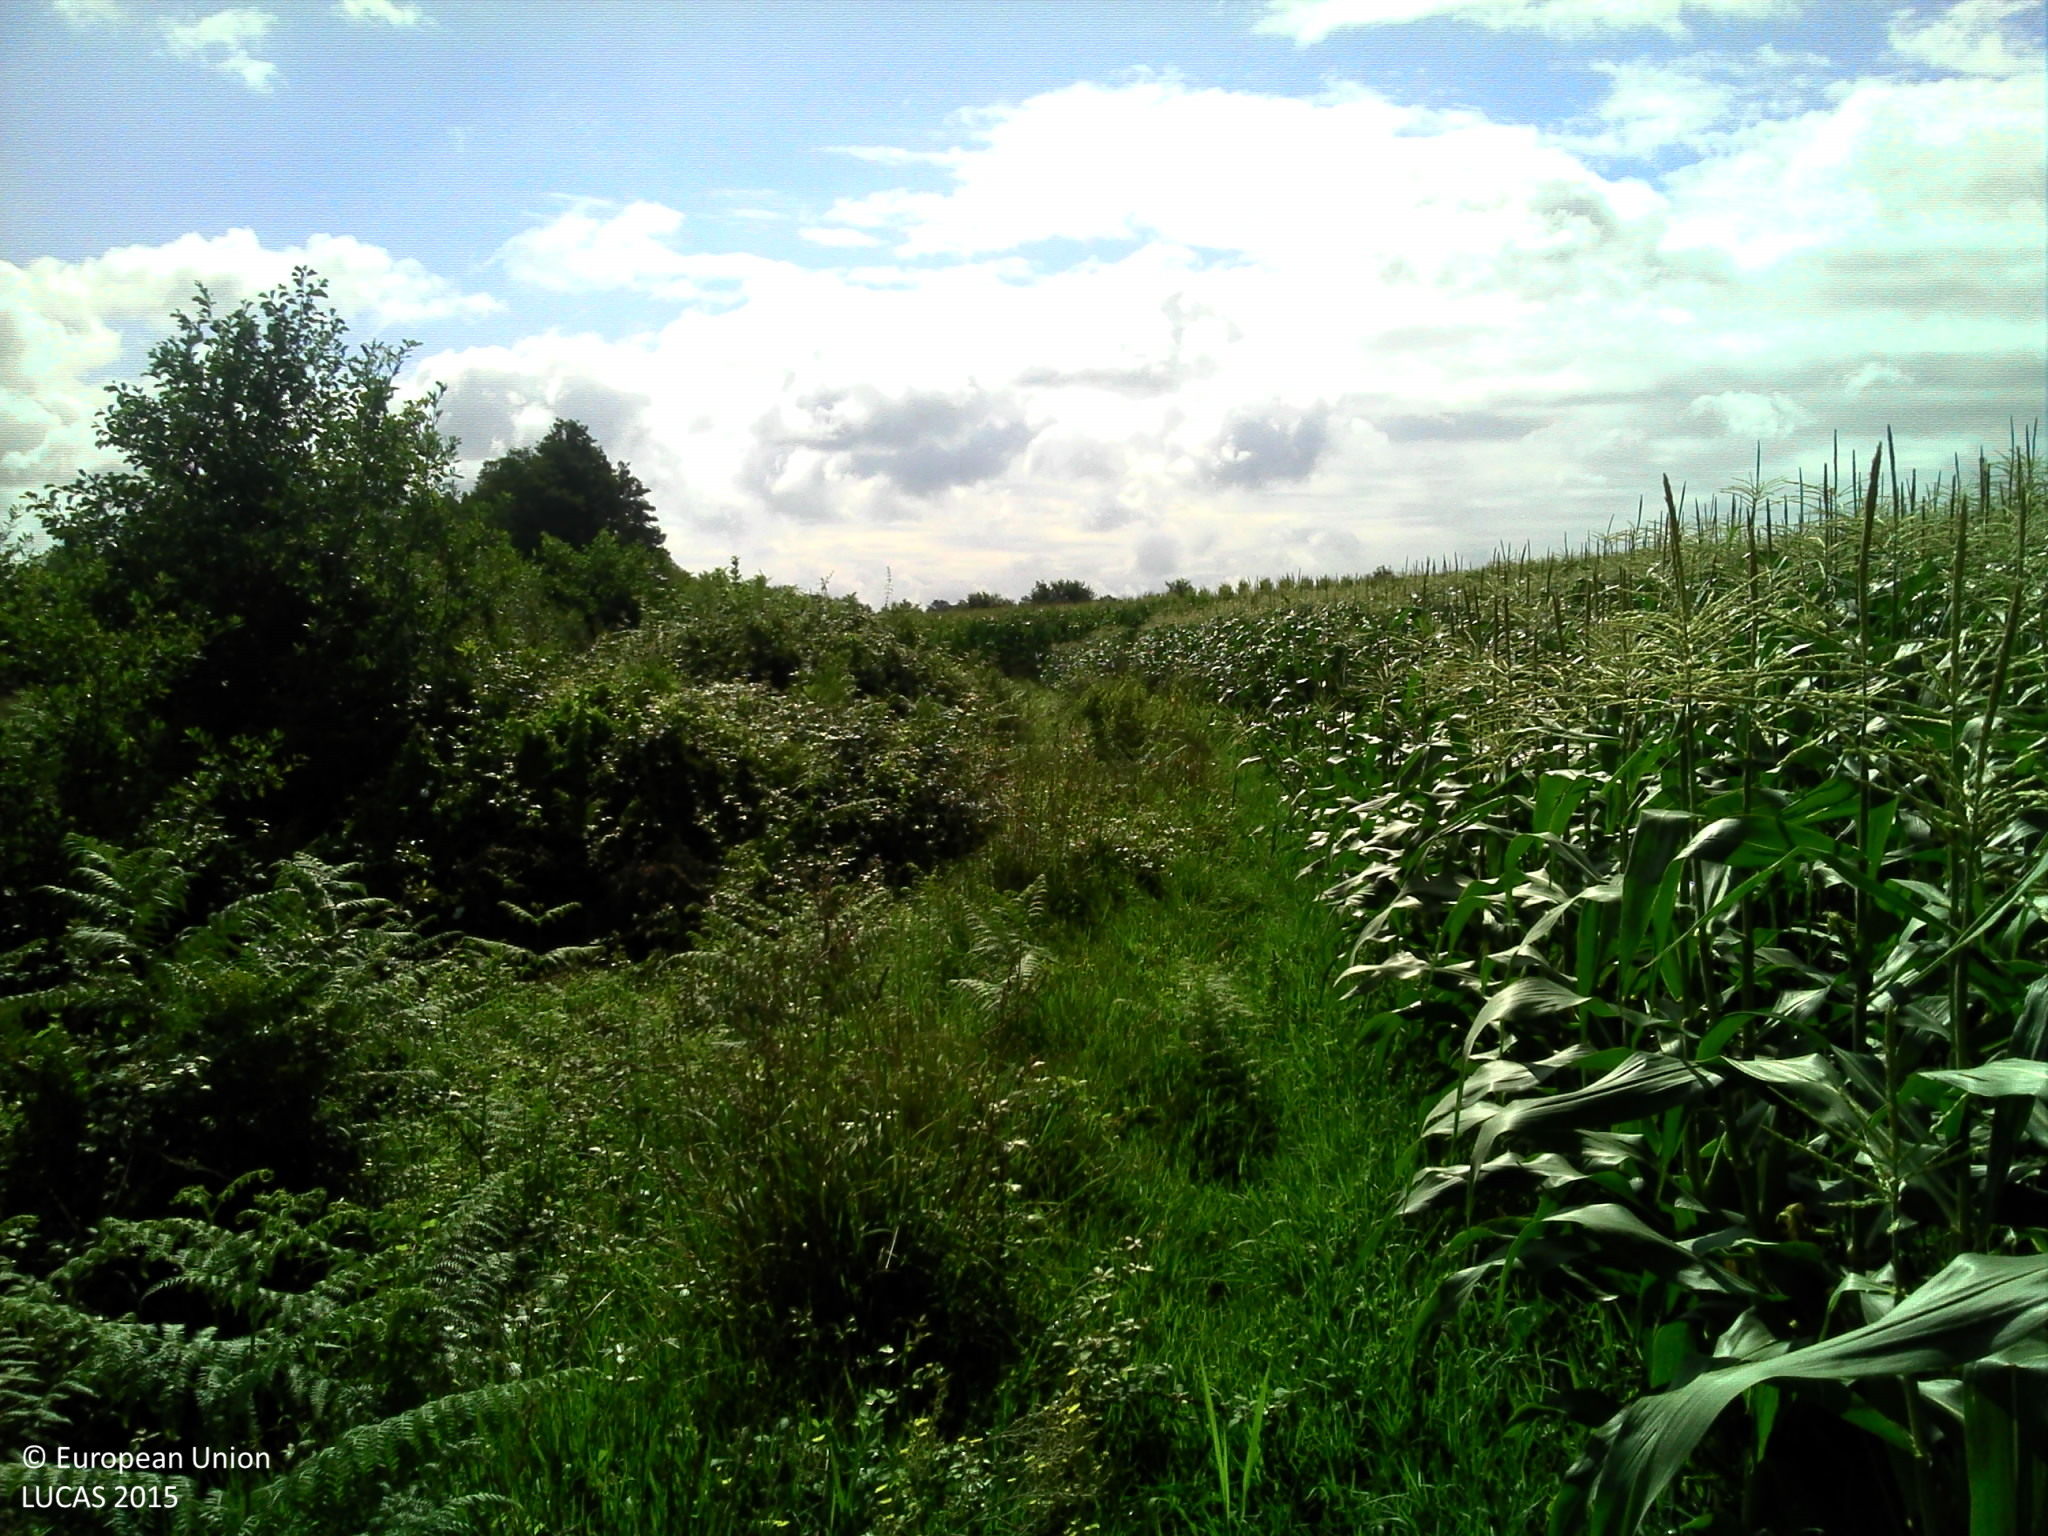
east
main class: Cropland
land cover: Maize
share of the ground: > 75 %
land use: Agriculture (excluding fallow land and kitchen gardens)
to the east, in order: Maize; Shruby margins; Rivers and streams; Broadleaved woodland; Shrubland without tree cover
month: July
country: FR
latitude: 43.8452
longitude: -0.7483
